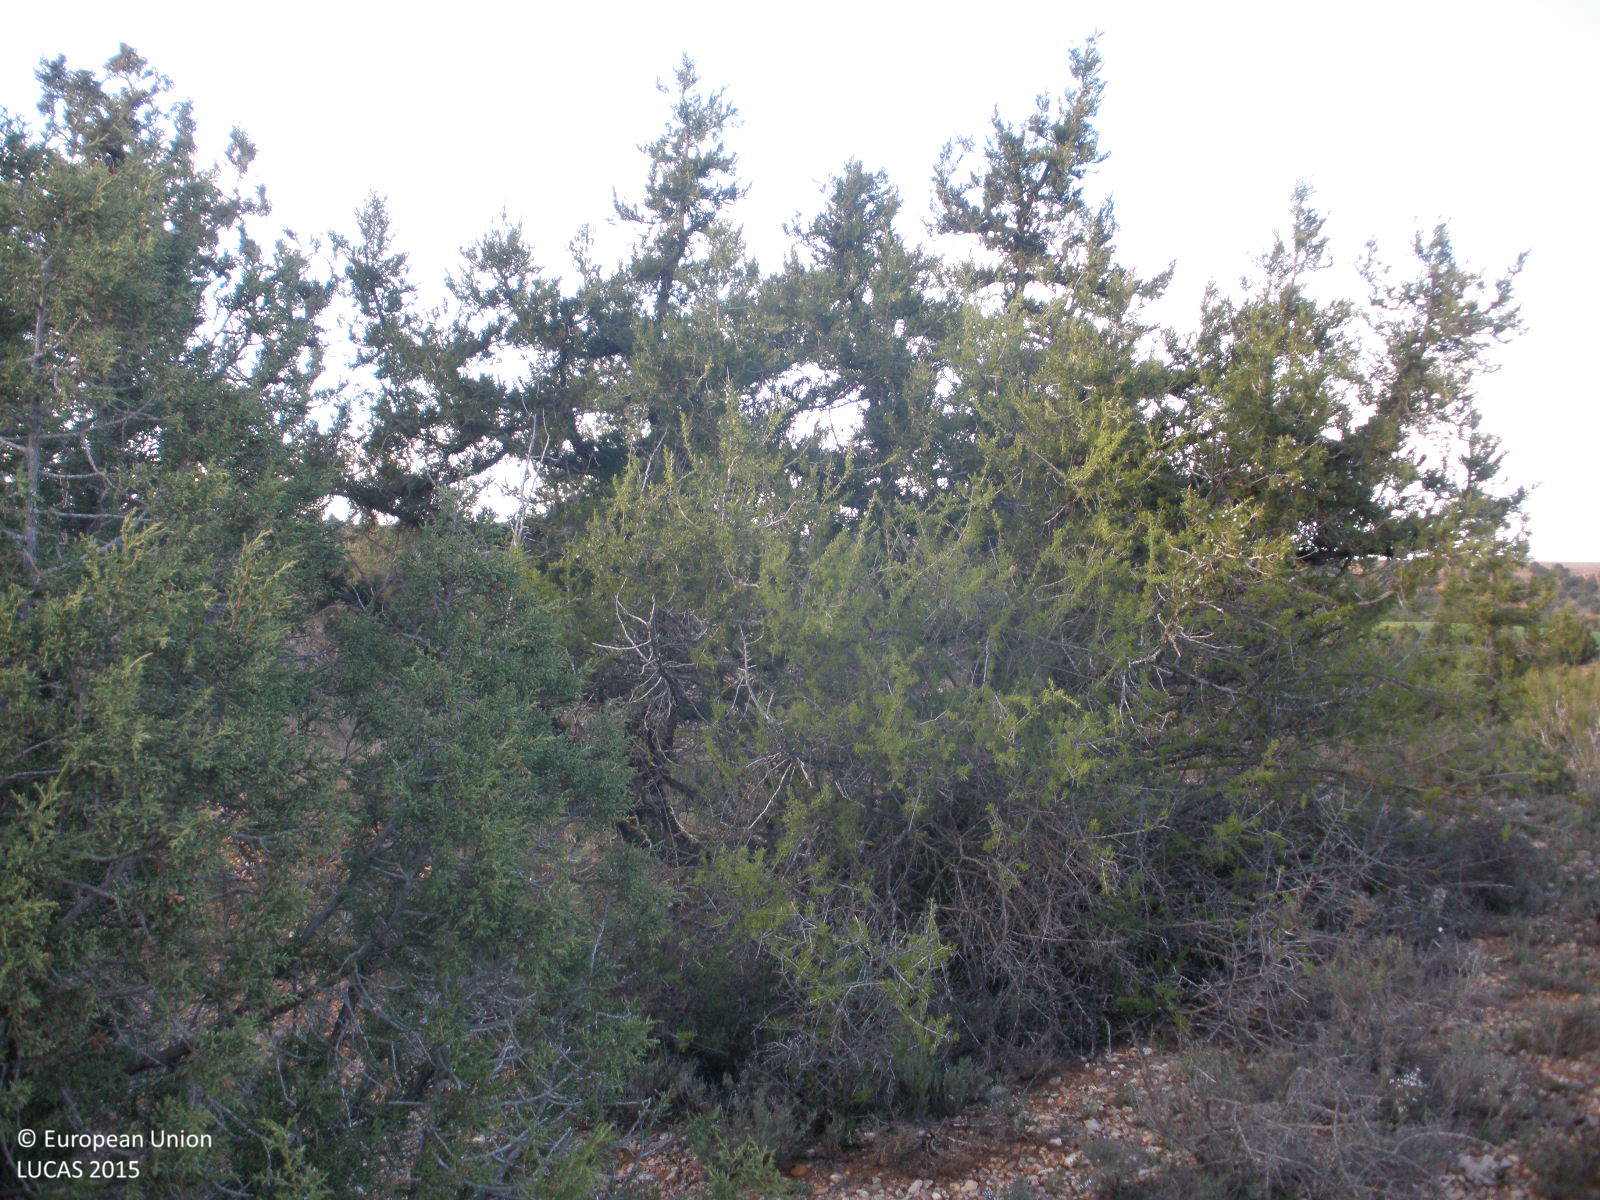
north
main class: Woodland
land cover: Other coniferous woodland
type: coniferous forest of the mediterranean region
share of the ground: 50 - 75 %
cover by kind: coniferous forest trees 60 %, consolidated bare surface 30 %, shrubs 10 %
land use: Semi-natural and natural areas not in use
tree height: < 5 m
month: April
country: ES
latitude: 40.3832
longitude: -1.2614
